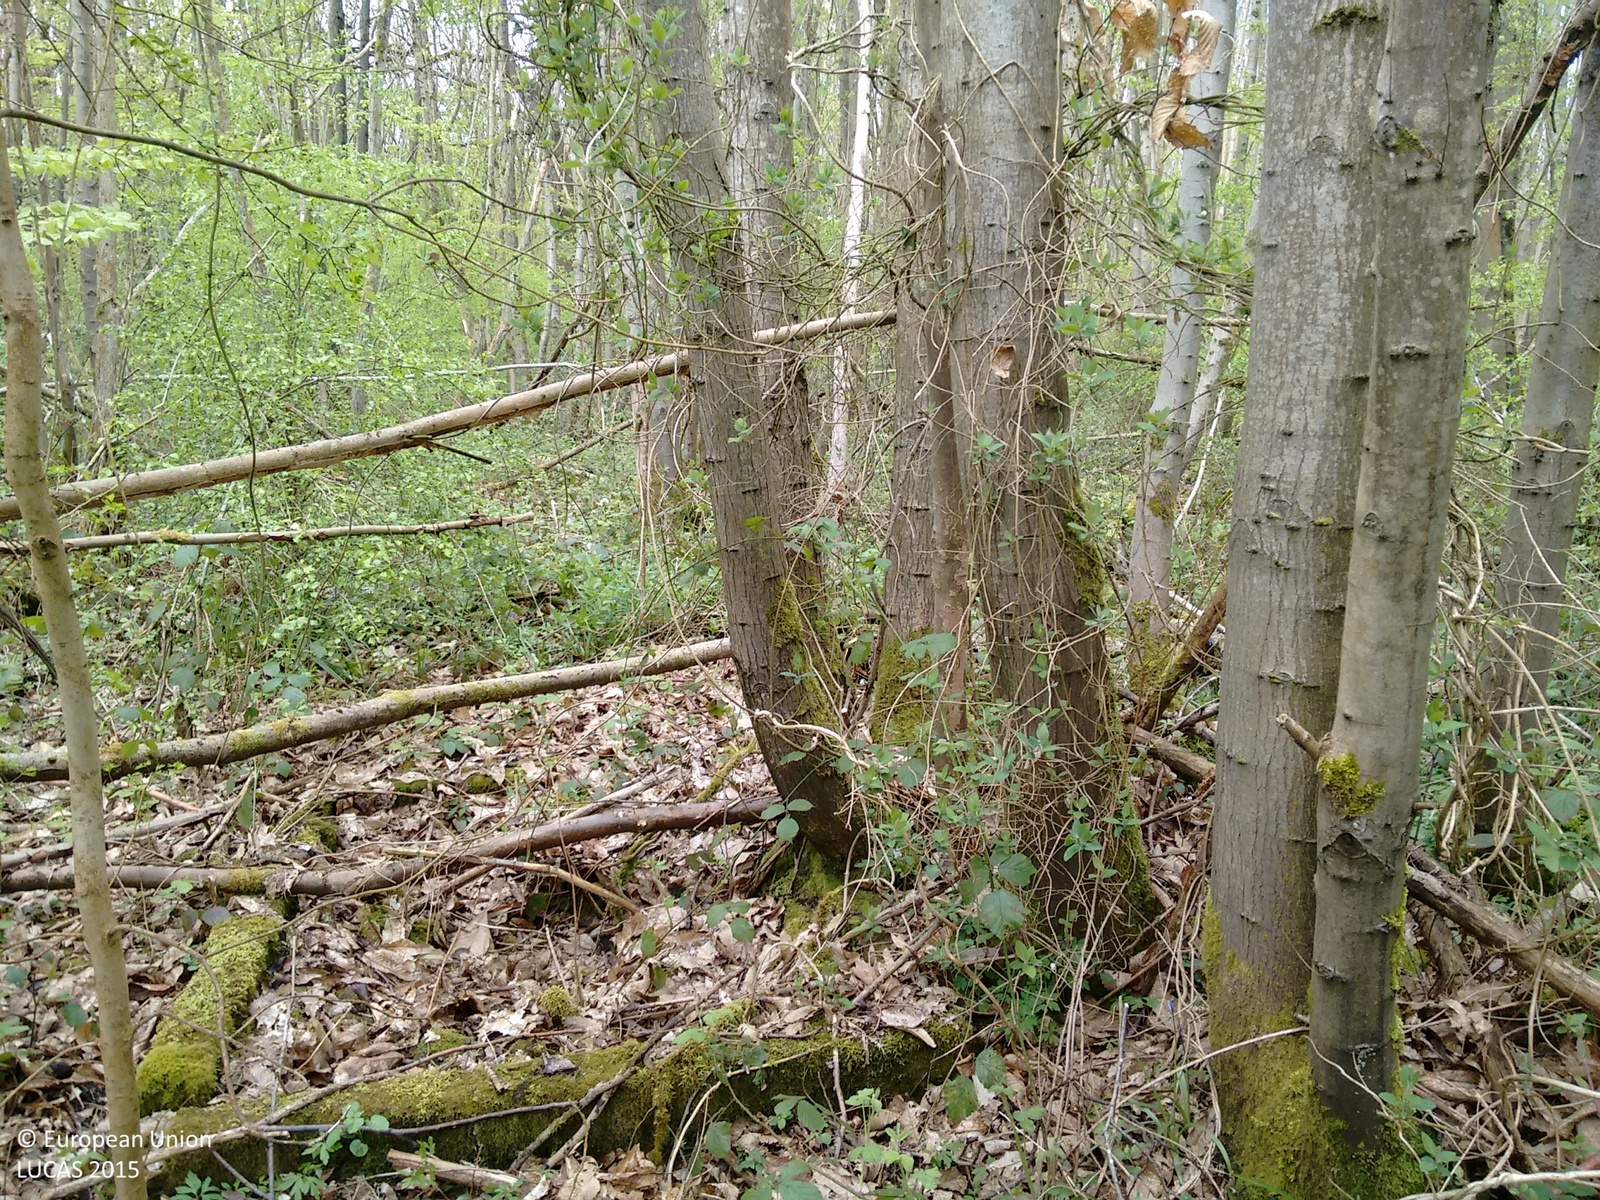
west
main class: Woodland
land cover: Broadleaved woodland
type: mesophytic deciduous forest
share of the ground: > 75 %
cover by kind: broadleaved forest trees 100 %
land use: Forestry
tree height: > 5 m
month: April
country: GB
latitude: 51.3331
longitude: 0.3687
